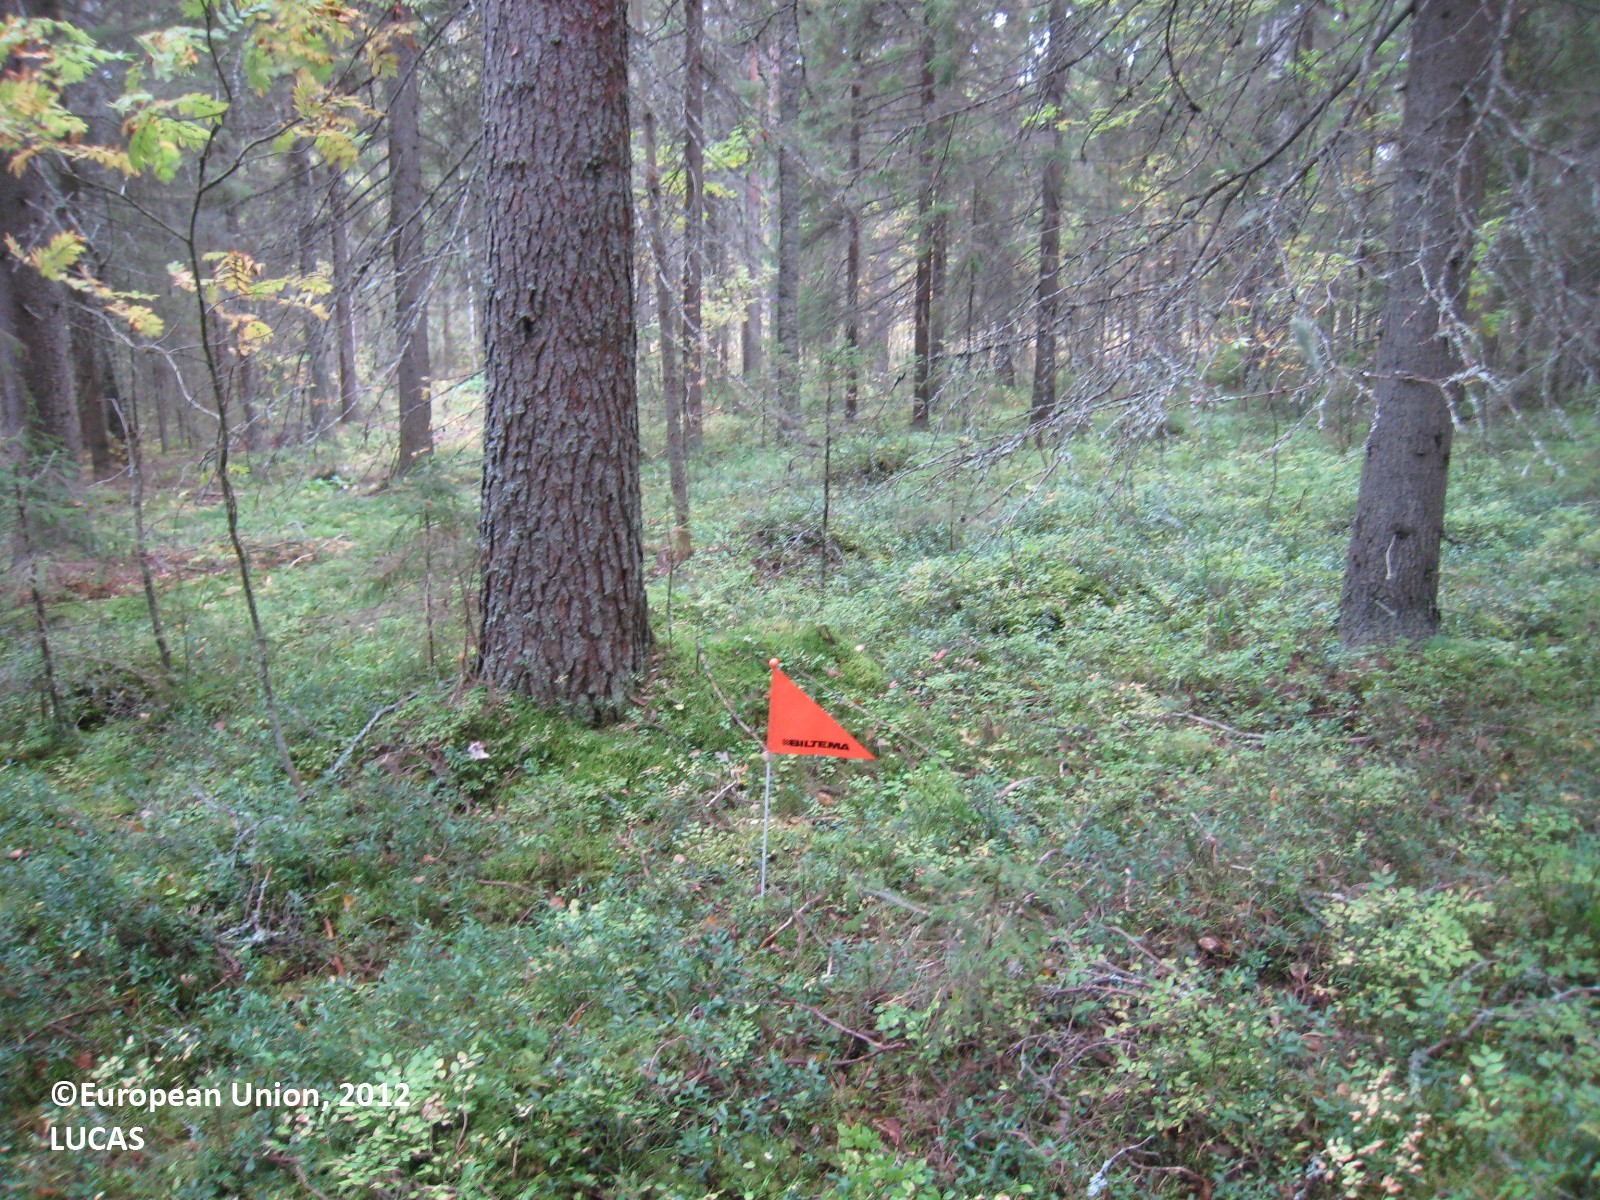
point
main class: Woodland
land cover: Spruce dominated coniferous woodland
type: boreal forest
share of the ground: > 75 %
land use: Forestry
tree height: > 5 m
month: September
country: FI
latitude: 62.7233
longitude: 26.5464
